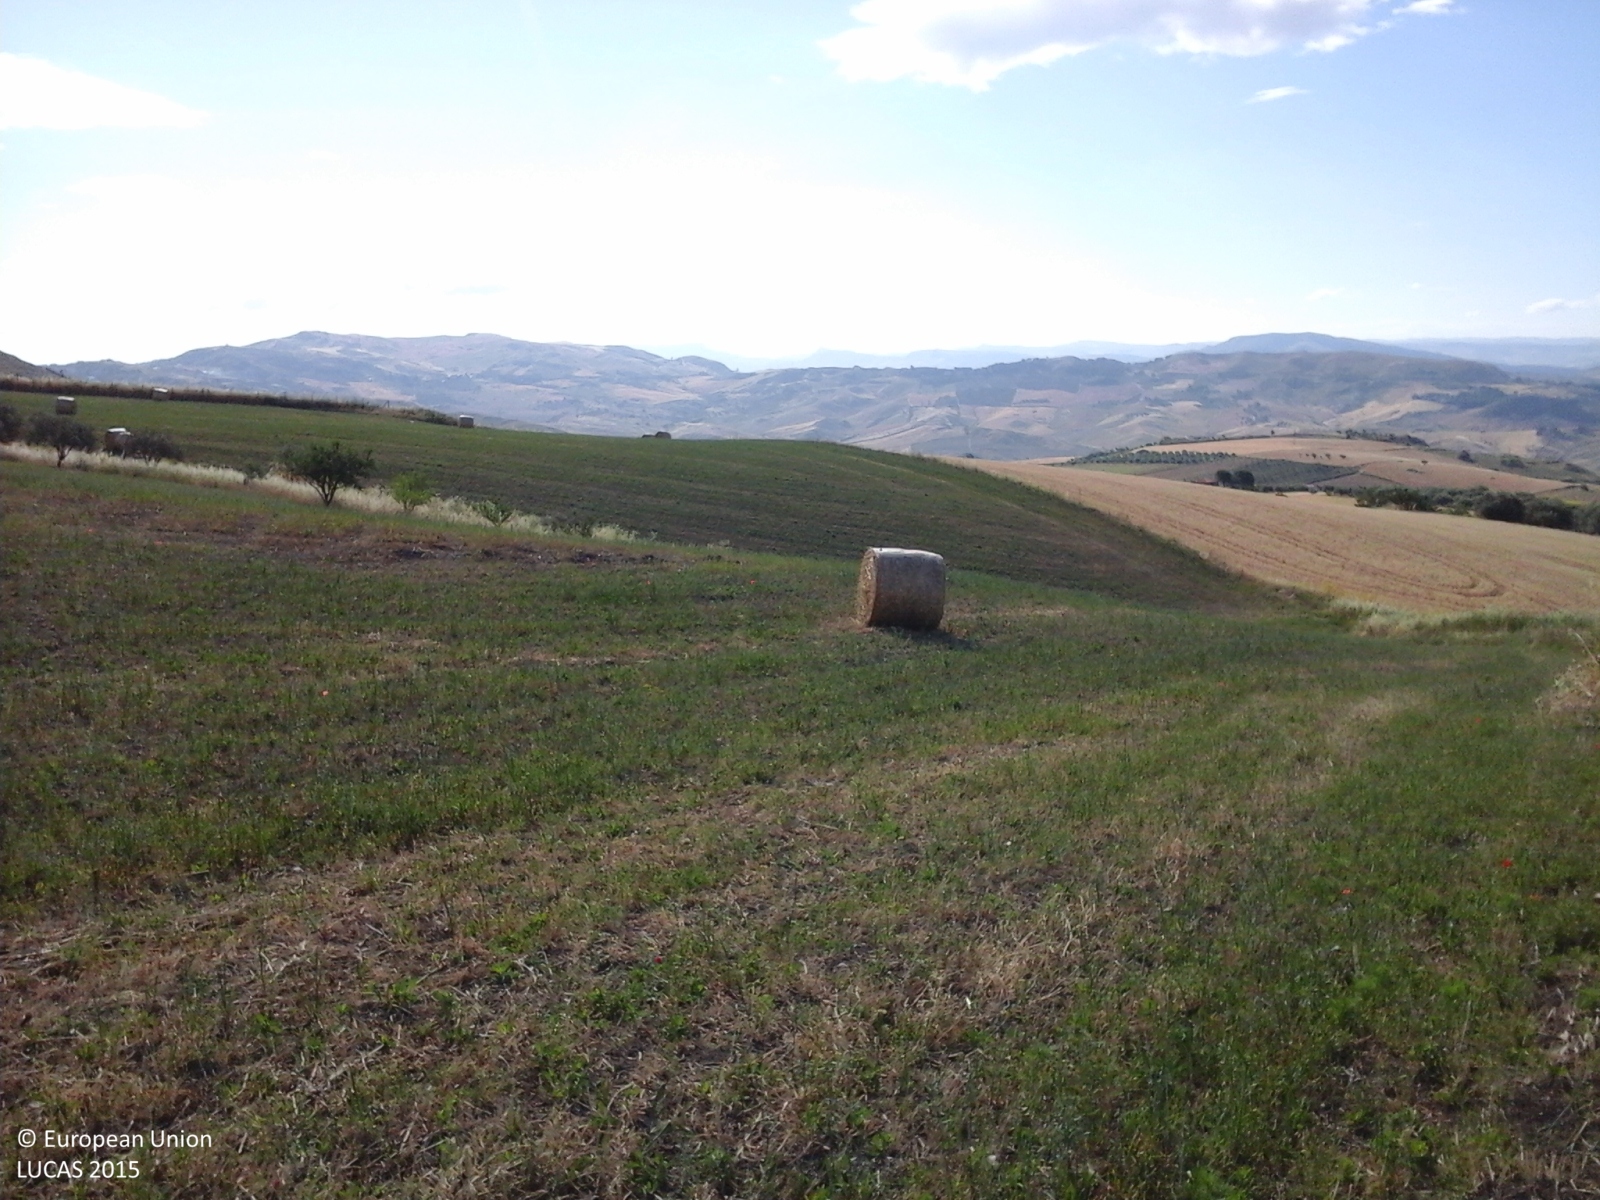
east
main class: Cropland
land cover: Durum wheat
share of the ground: > 75 %
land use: Agriculture (excluding fallow land and kitchen gardens)
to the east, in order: Durum wheat; Grass margins; Durum wheat; Grass margins; Other leguminous and mixtures for fodder; Grass margins; Durum wheat; Grass margins; Other bare soil
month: June
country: IT
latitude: 37.5720
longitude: 14.0124
